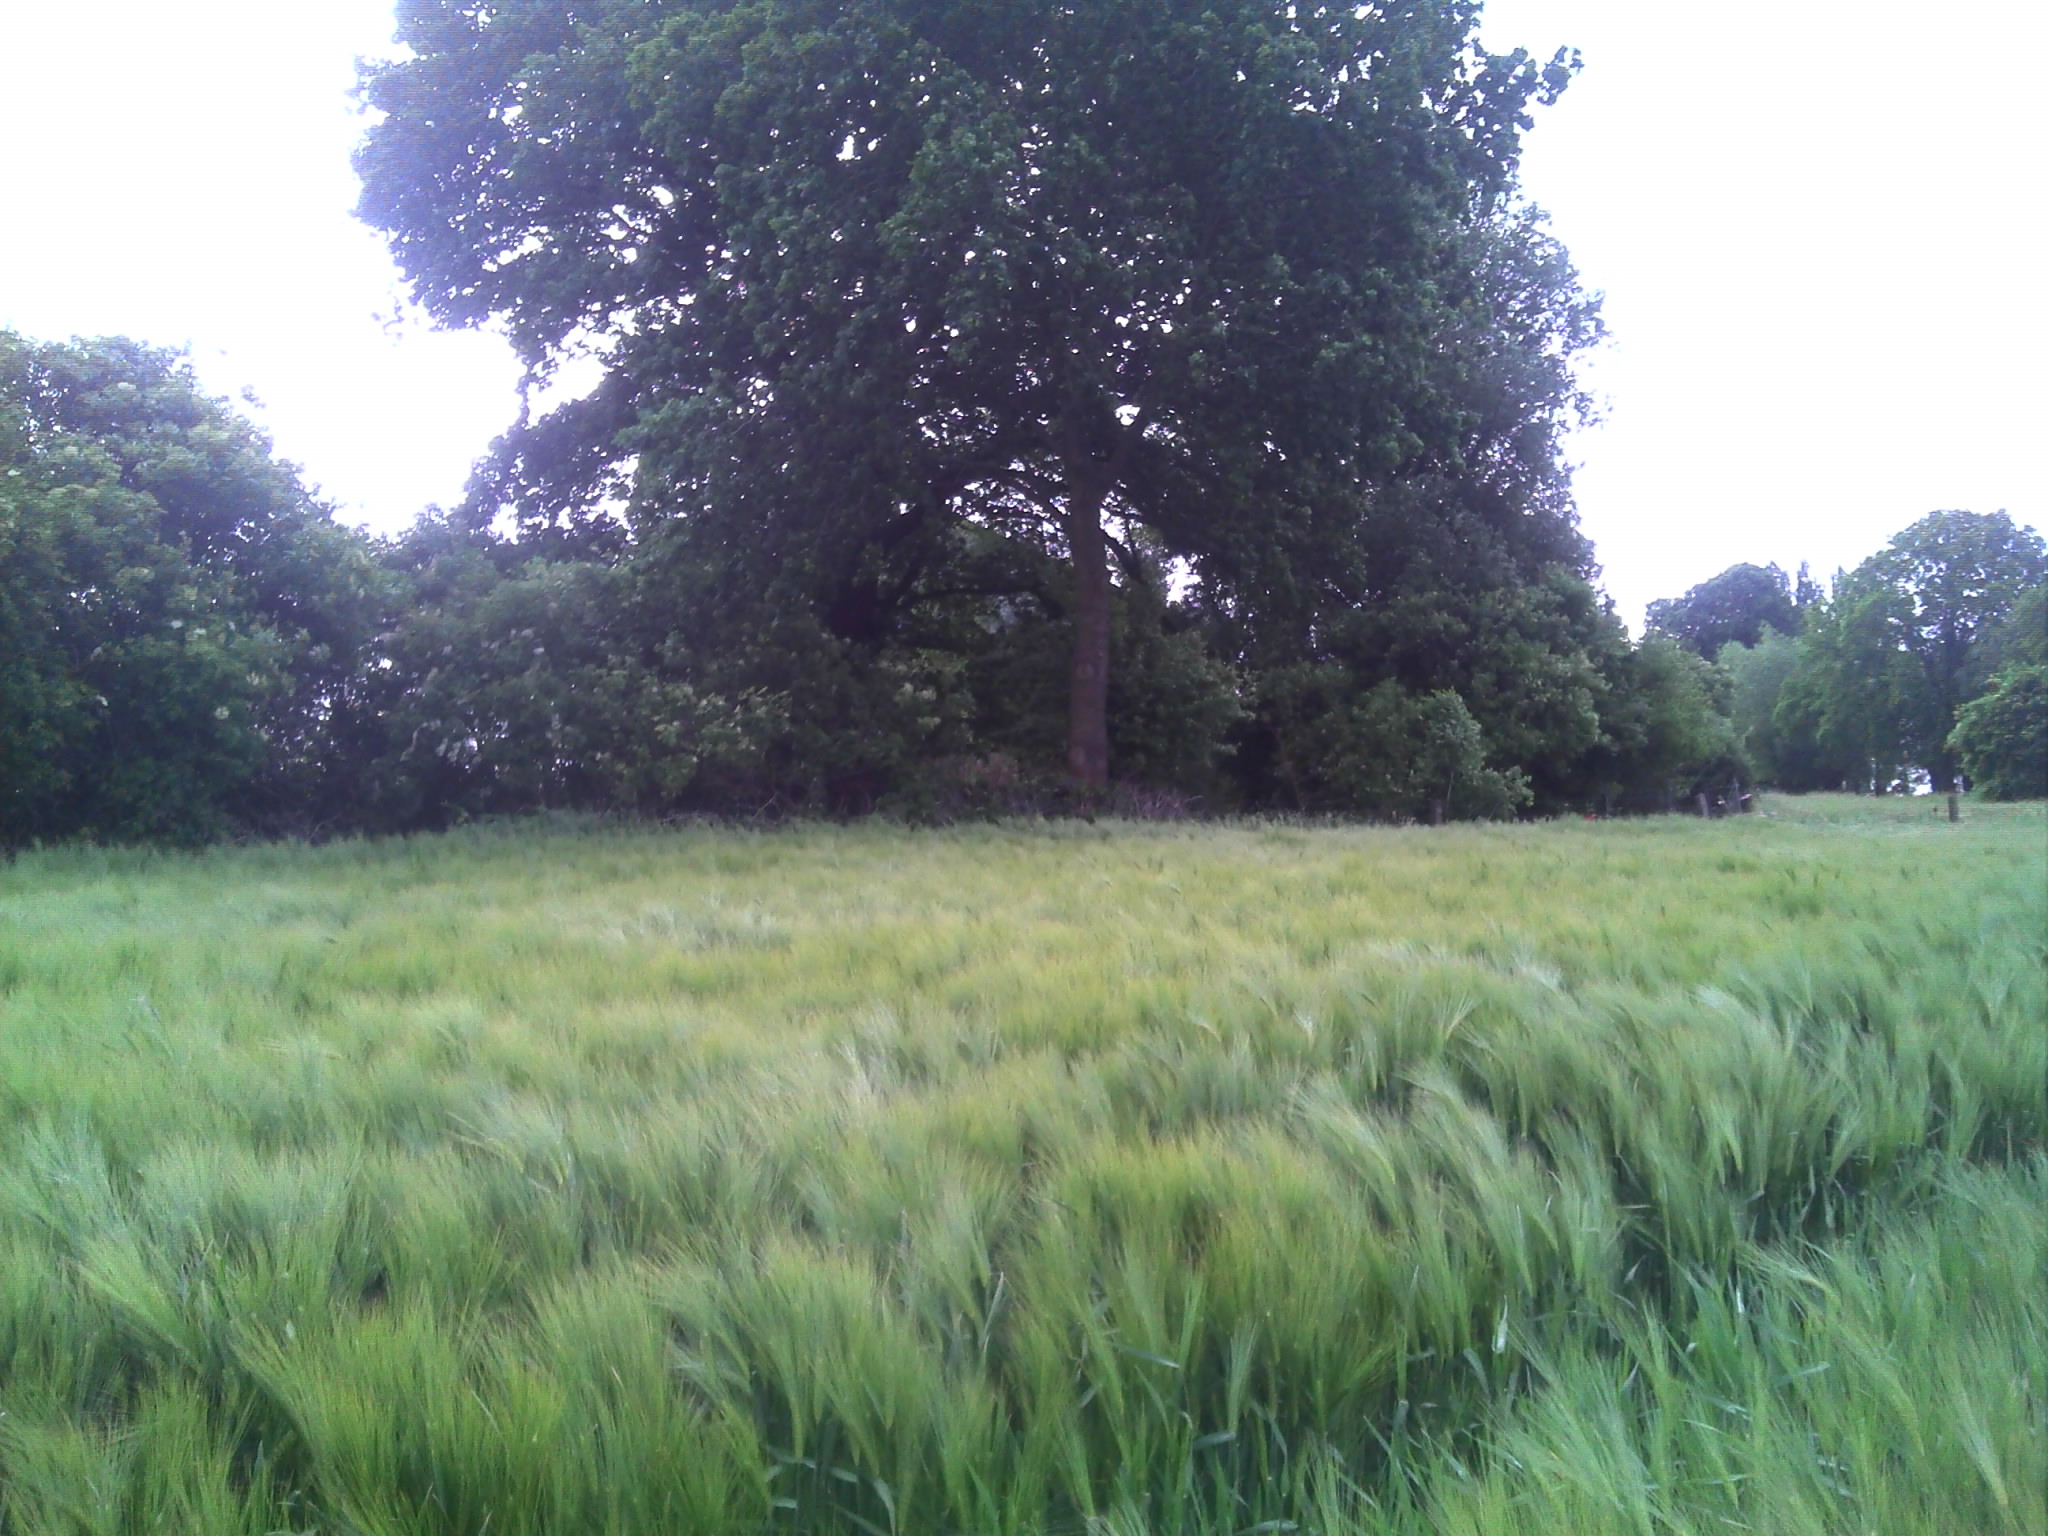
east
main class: Cropland
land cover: Barley
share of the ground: > 75 %
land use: Agriculture (excluding fallow land and kitchen gardens)
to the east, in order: Barley; Abandoned hedges; Grassland with sparse tree/shrub cover; Fences; Grassland without tree/shrub cover; Artificial constructions in urban areas; Grassland without tree/shrub cover; Managed hedges; Grass margins; Paved roads, cycling and walking lanes; Electric lines; Common wheat
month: June
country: BE
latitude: 50.5425
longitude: 4.5916
